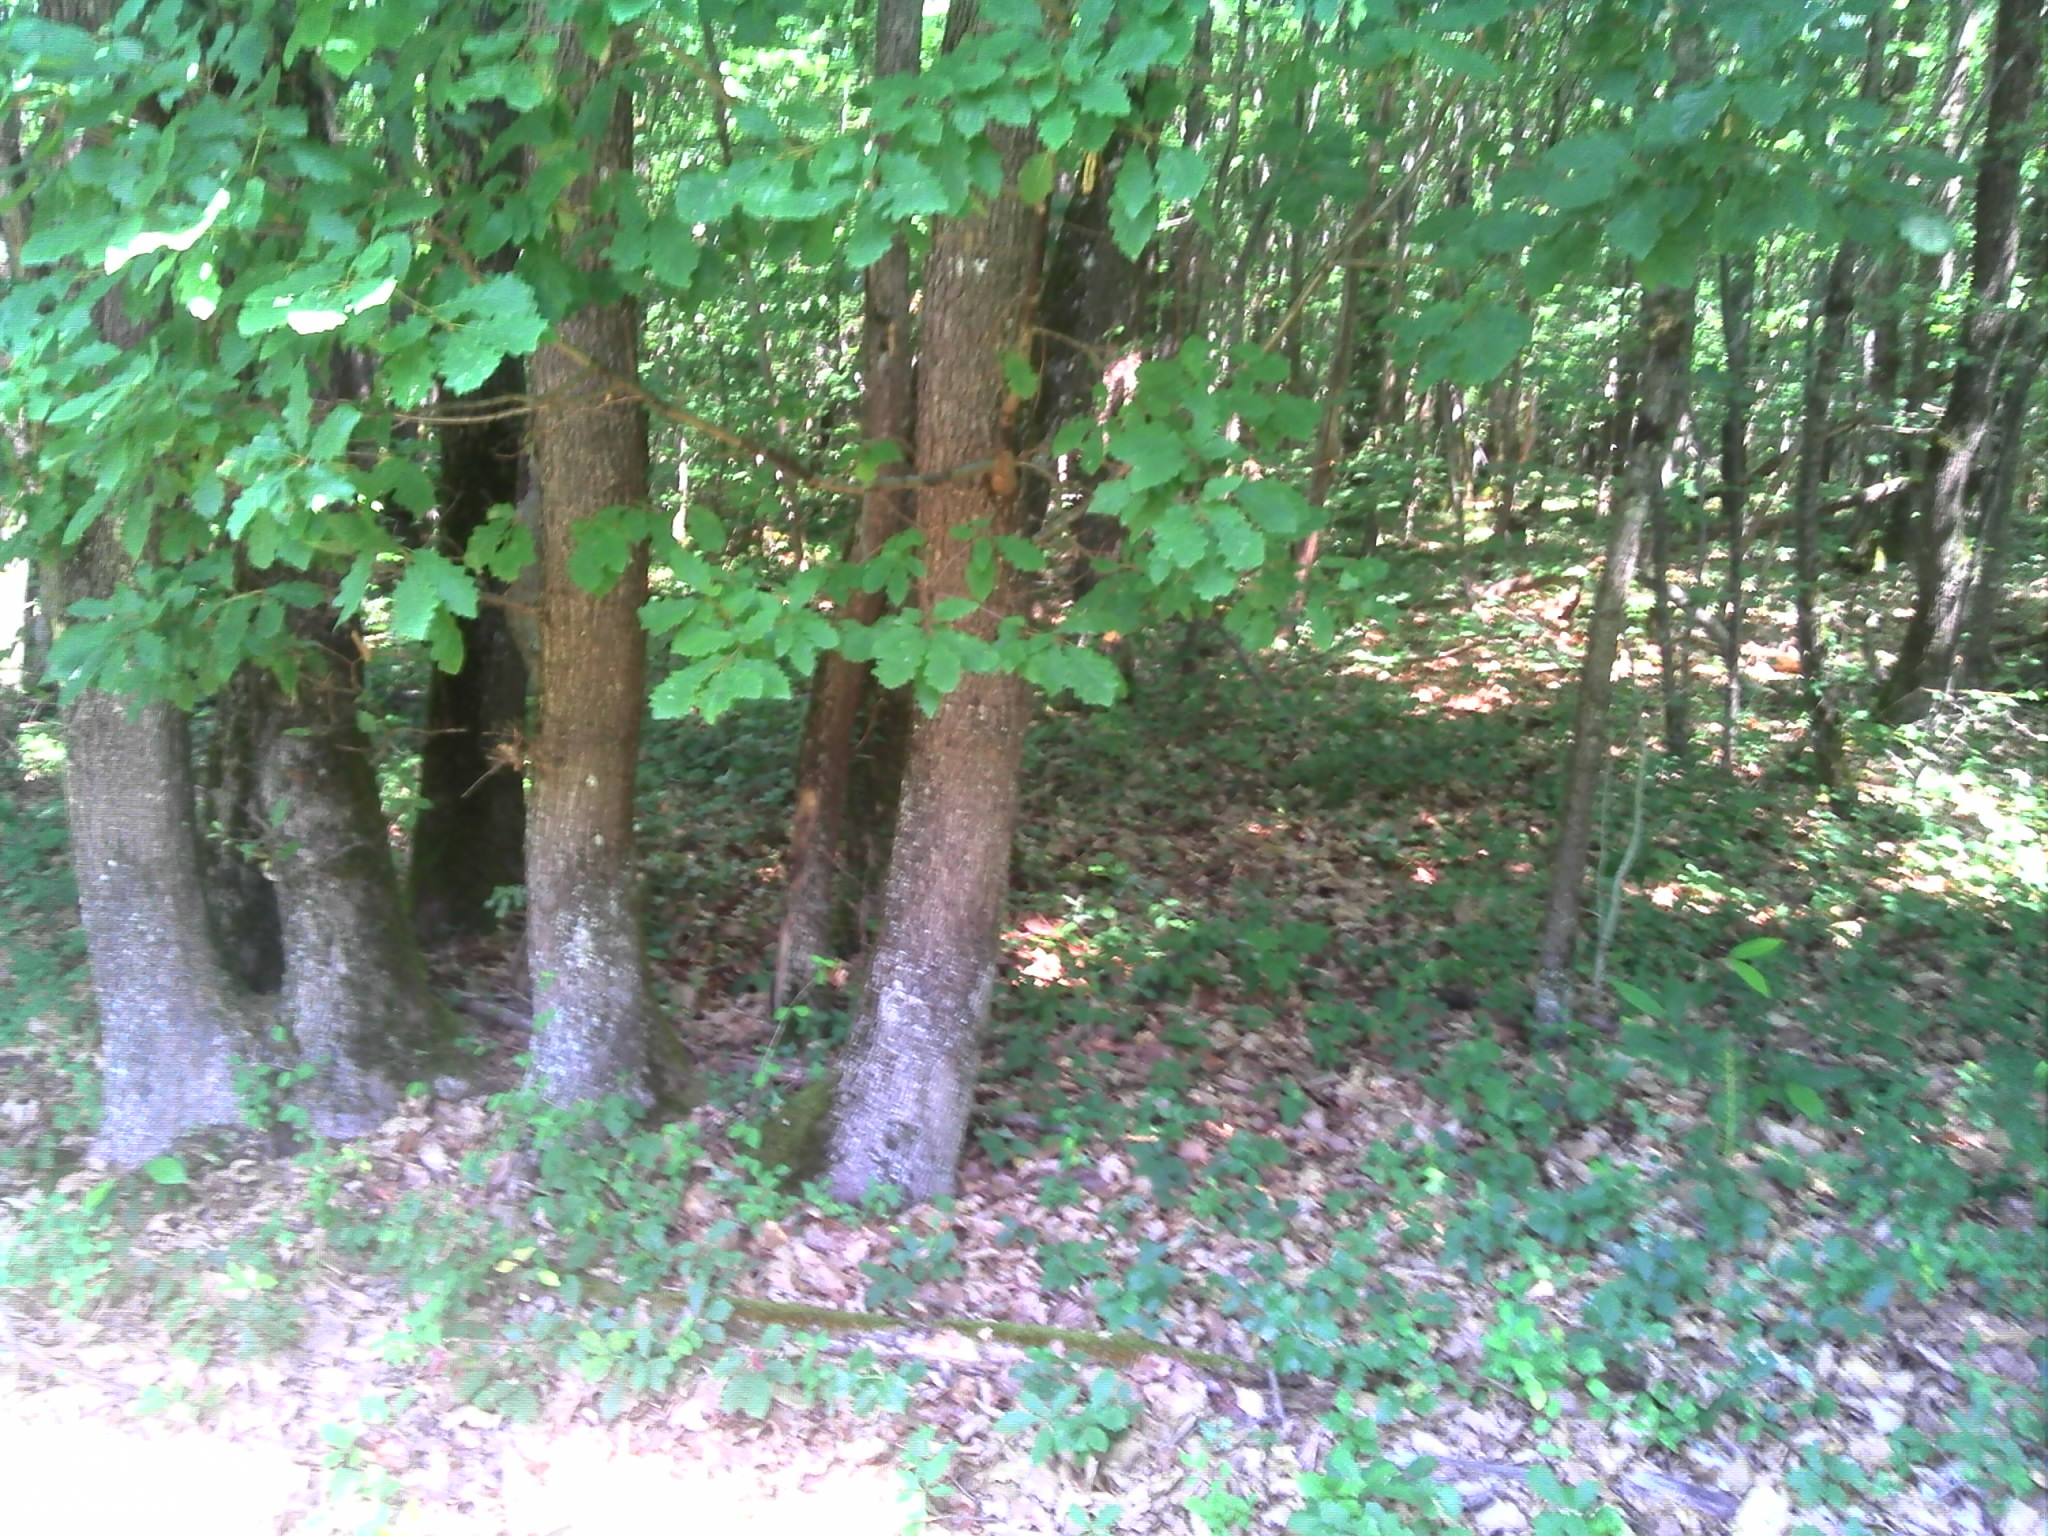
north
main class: Woodland
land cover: Broadleaved woodland
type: mesophytic deciduous forest
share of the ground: > 75 %
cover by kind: broadleaved forest trees 80 %, herbaceous plants 10 %, coniferous forest trees 5 %, lichens and mosses 5 %
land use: Forestry
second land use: Amenities, museums, leisure
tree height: > 5 m
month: June
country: FR
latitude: 47.4368
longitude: 0.7657
